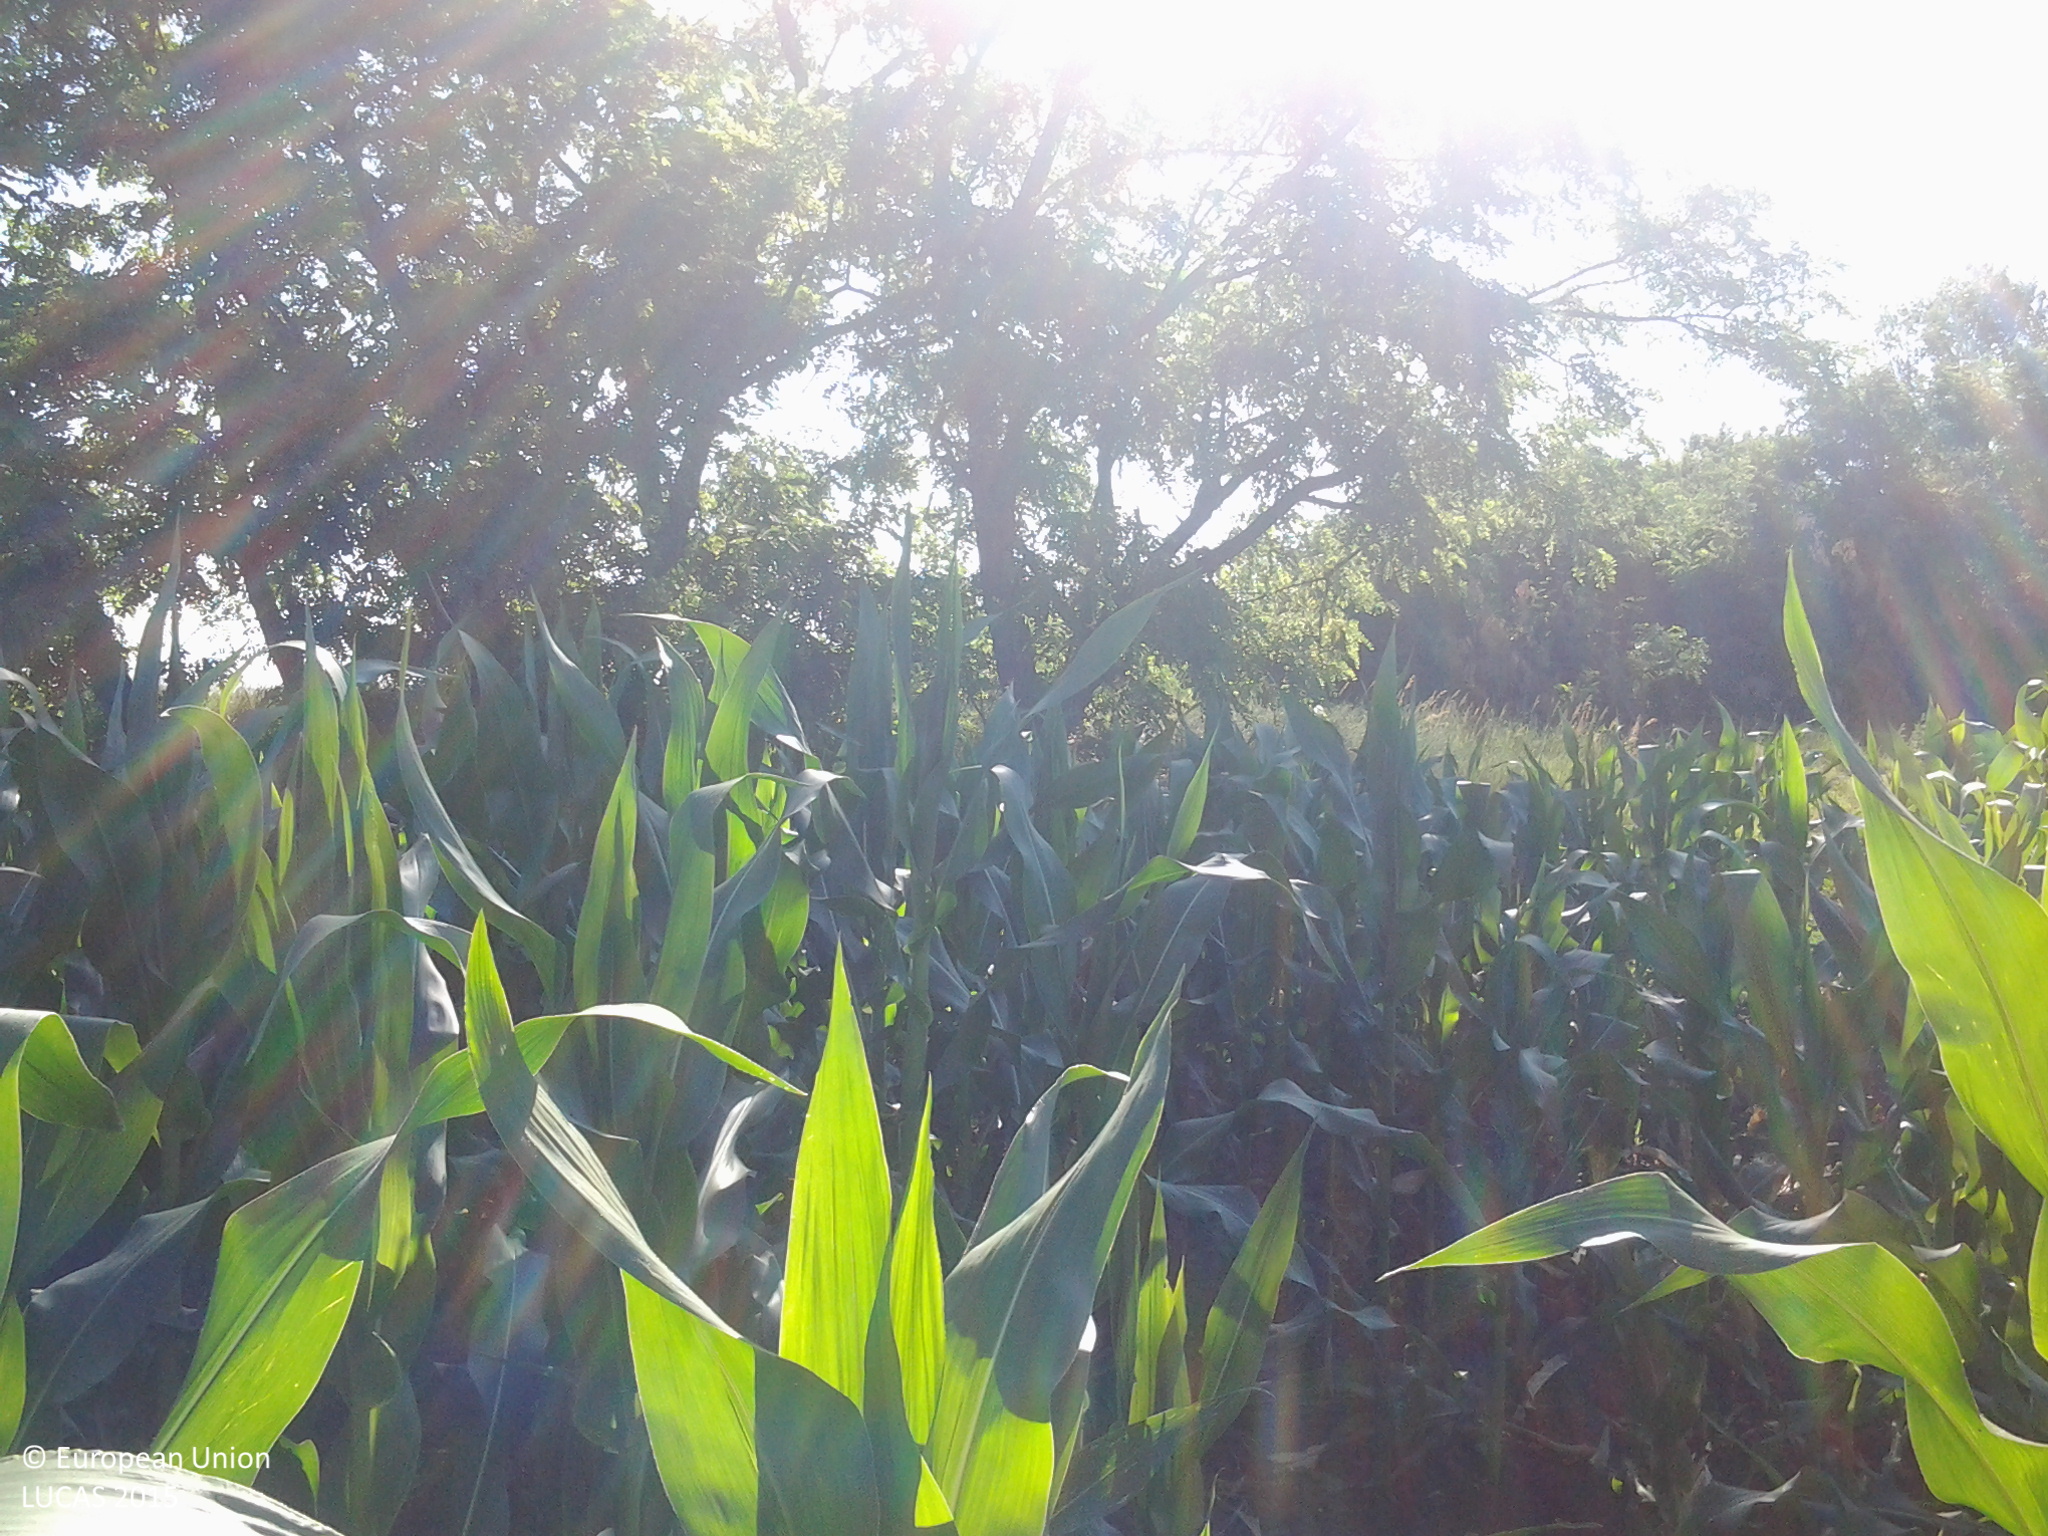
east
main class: Cropland
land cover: Maize
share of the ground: > 75 %
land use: Agriculture (excluding fallow land and kitchen gardens)
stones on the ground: < 10 %
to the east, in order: Maize; Broadleaved woodland; Tracks; Grassland with sparse tree/shrub cover; Barley
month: June
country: HU
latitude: 46.9652
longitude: 19.6542
